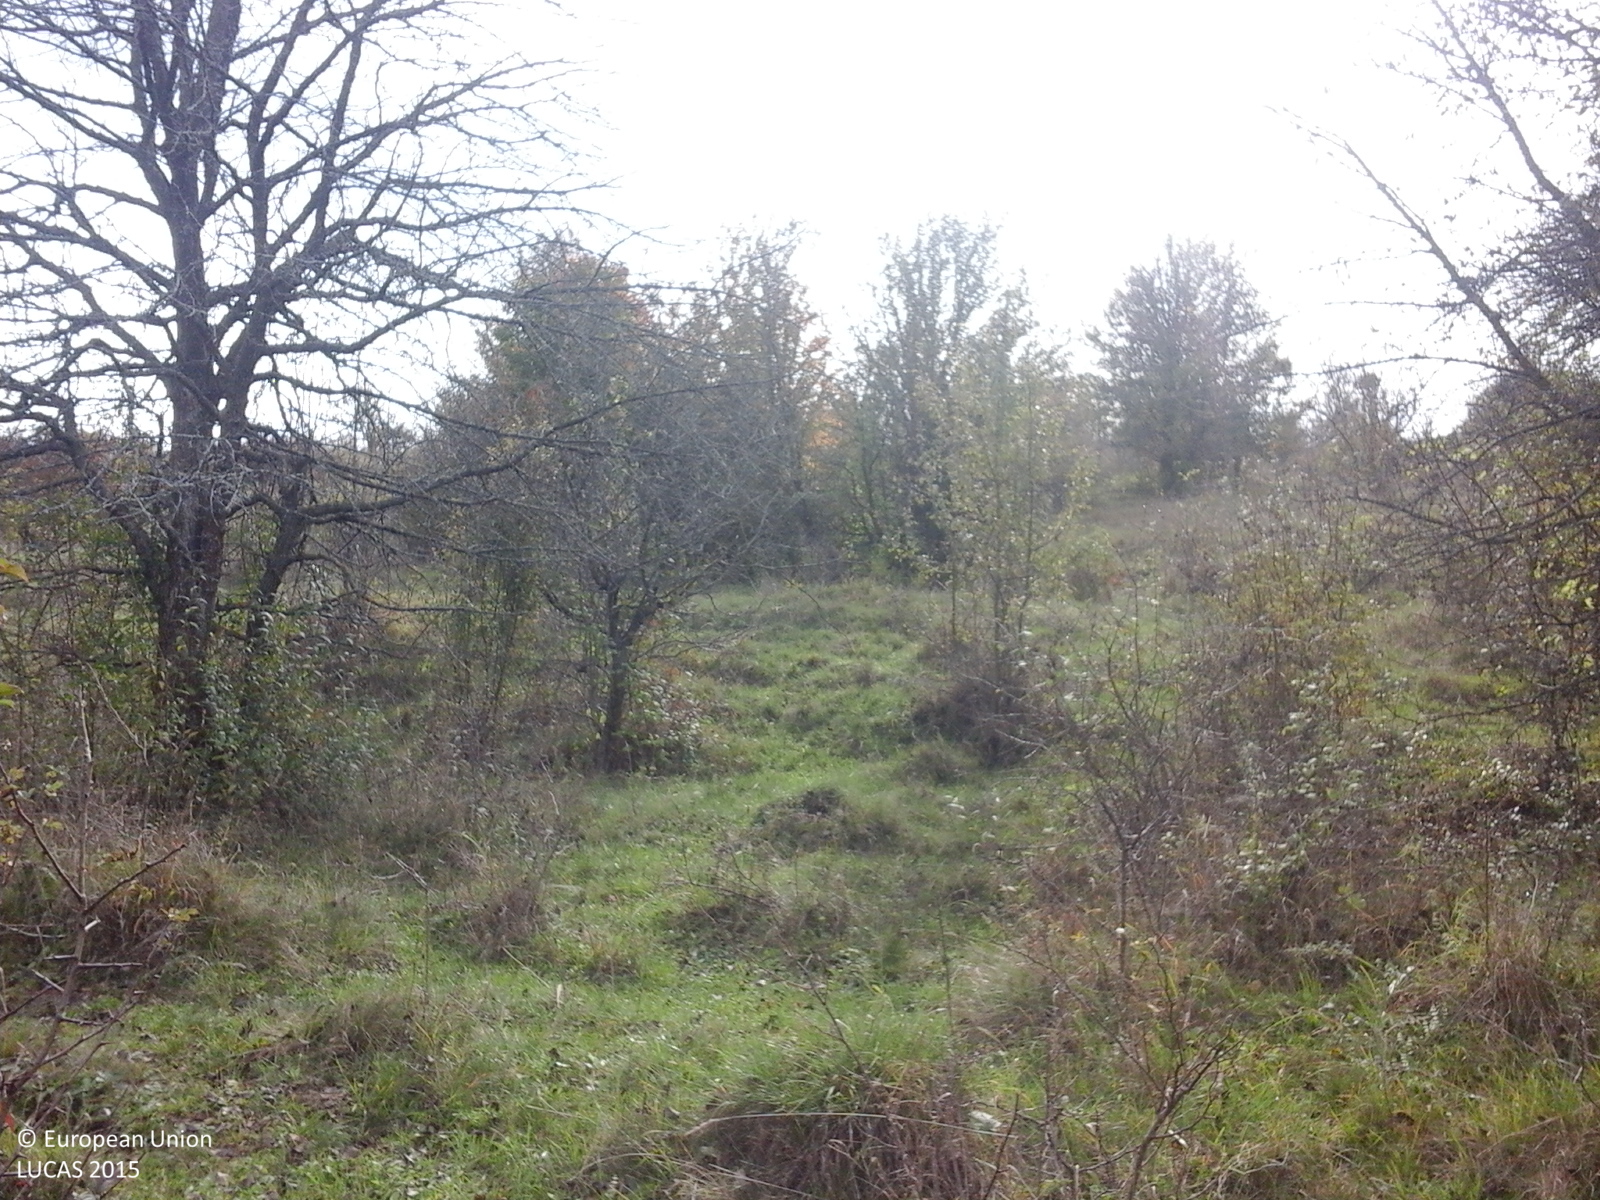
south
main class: Shrubland
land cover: Shrubland with sparse tree cover
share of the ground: > 75 %
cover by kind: herbaceous plants 60 %, shrubs 35 %, broadleaved forest trees 5 %
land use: Fallow land
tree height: < 5 m
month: October
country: RO
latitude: 46.2548
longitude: 25.2659
